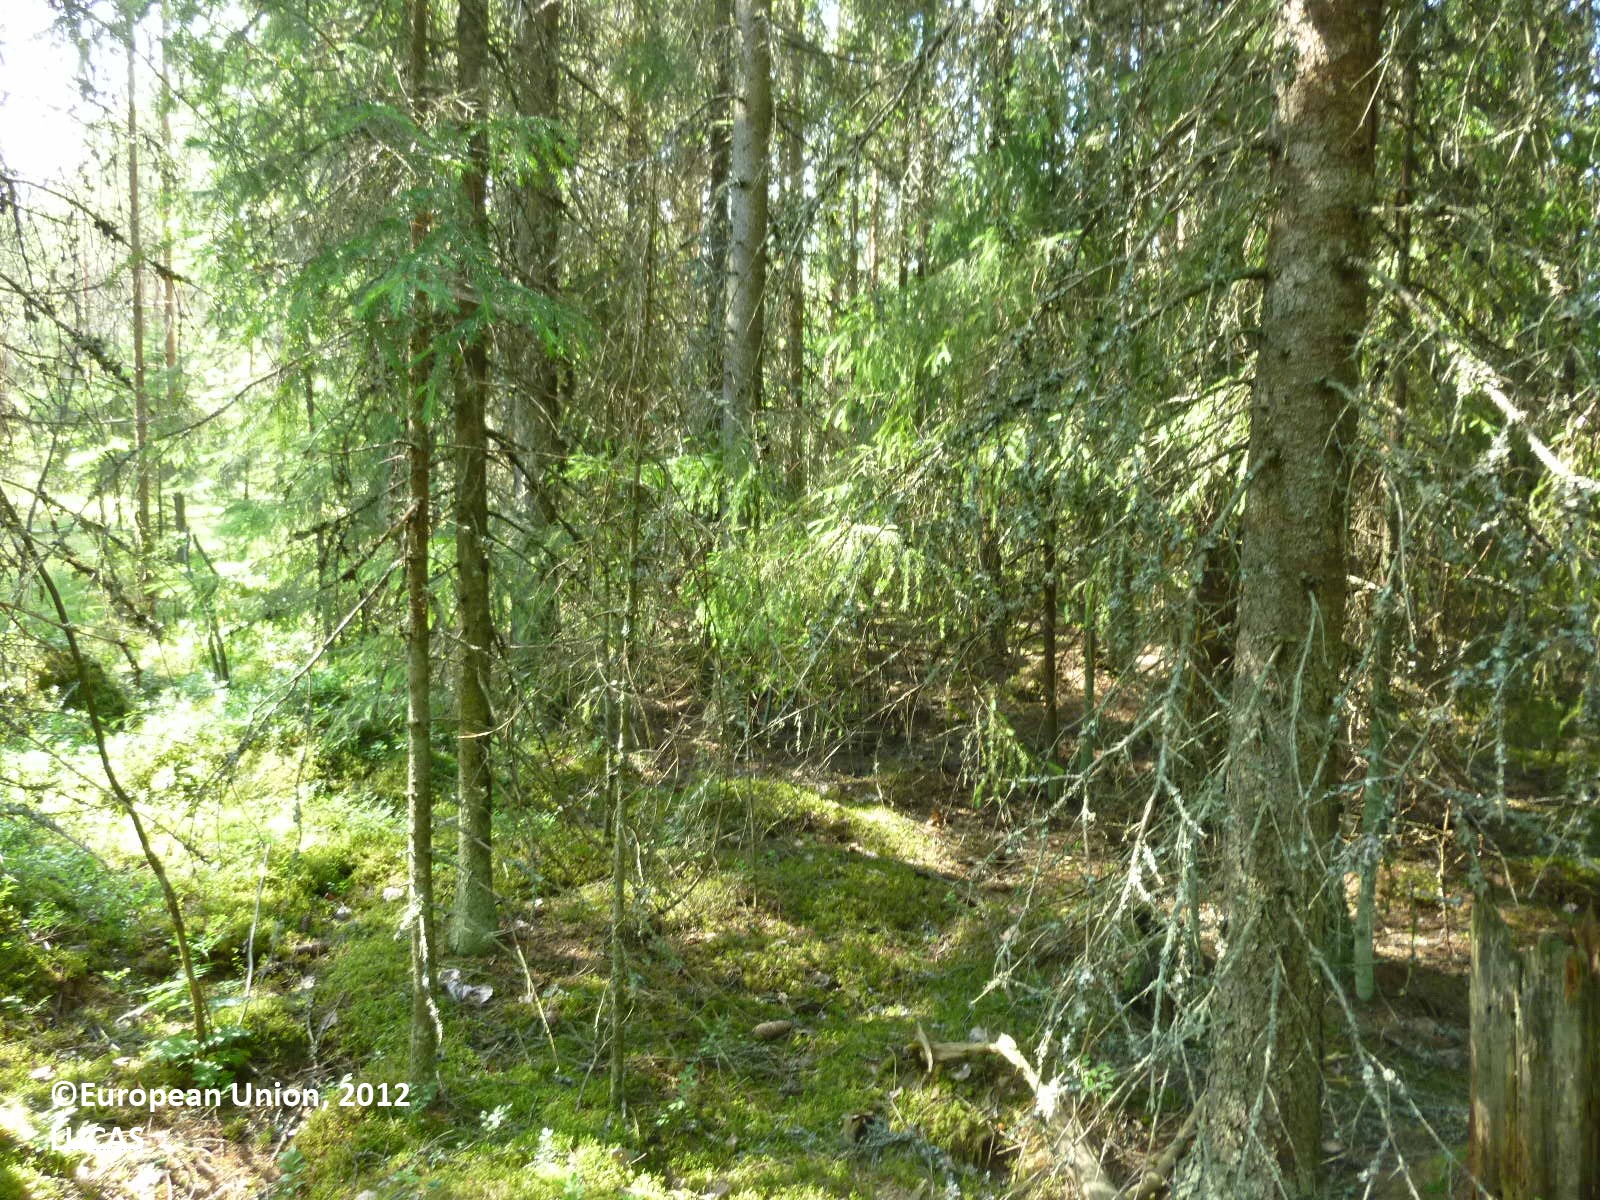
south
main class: Woodland
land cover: Spruce dominated coniferous woodland
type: boreal forest
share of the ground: > 75 %
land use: Forestry
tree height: > 5 m
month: July
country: FI
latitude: 61.1326
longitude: 22.5634
